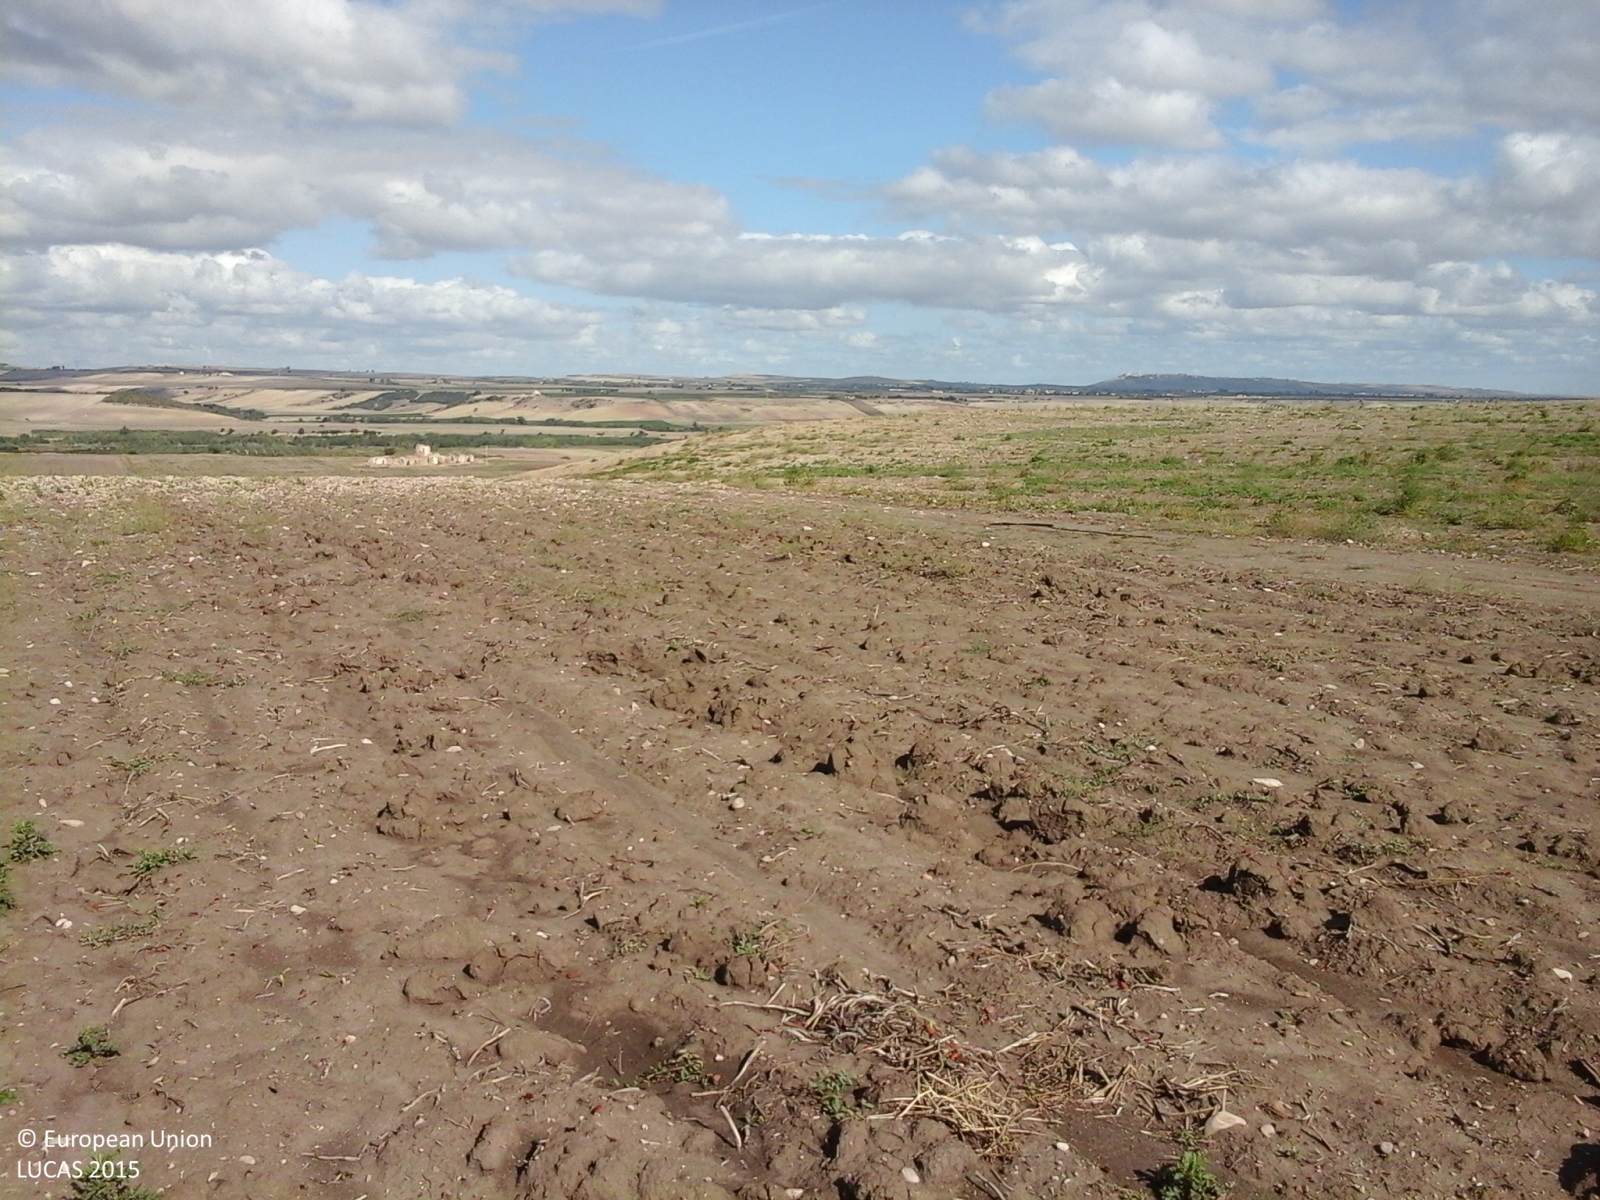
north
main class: Cropland
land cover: Dry pulses
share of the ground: > 75 %
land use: Agriculture (excluding fallow land and kitchen gardens)
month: September
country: IT
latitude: 41.6898
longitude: 15.1617
